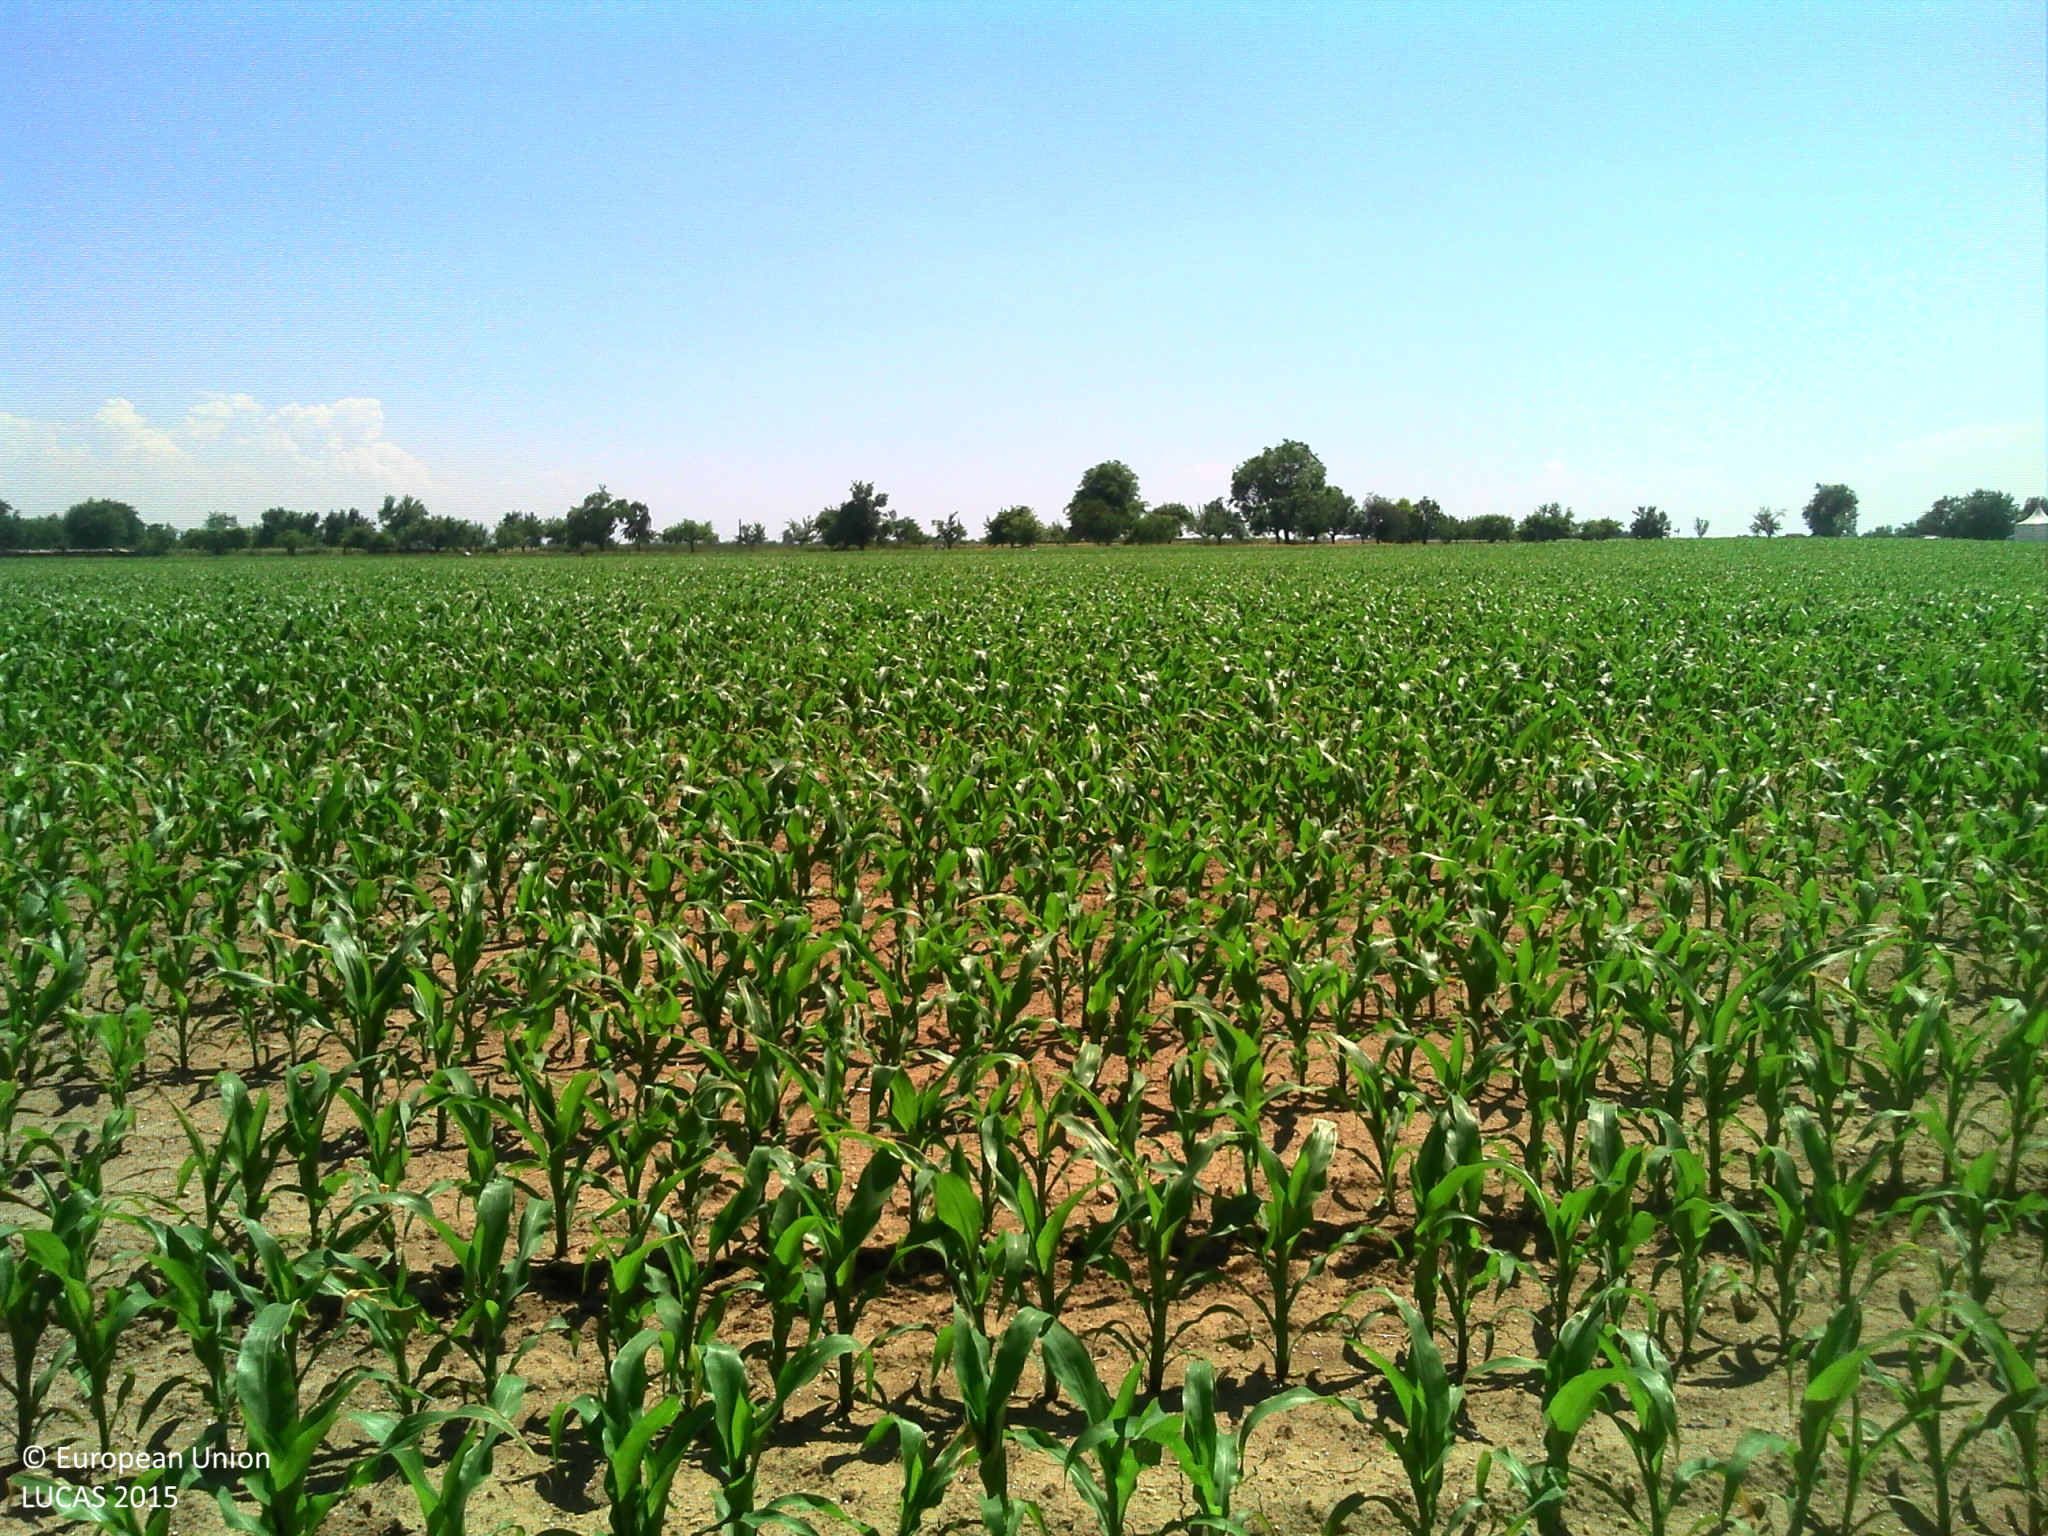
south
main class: Cropland
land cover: Maize
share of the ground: 10 - 25 %
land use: Agriculture (excluding fallow land and kitchen gardens)
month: June
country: FR
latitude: 48.4508
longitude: 7.6618
